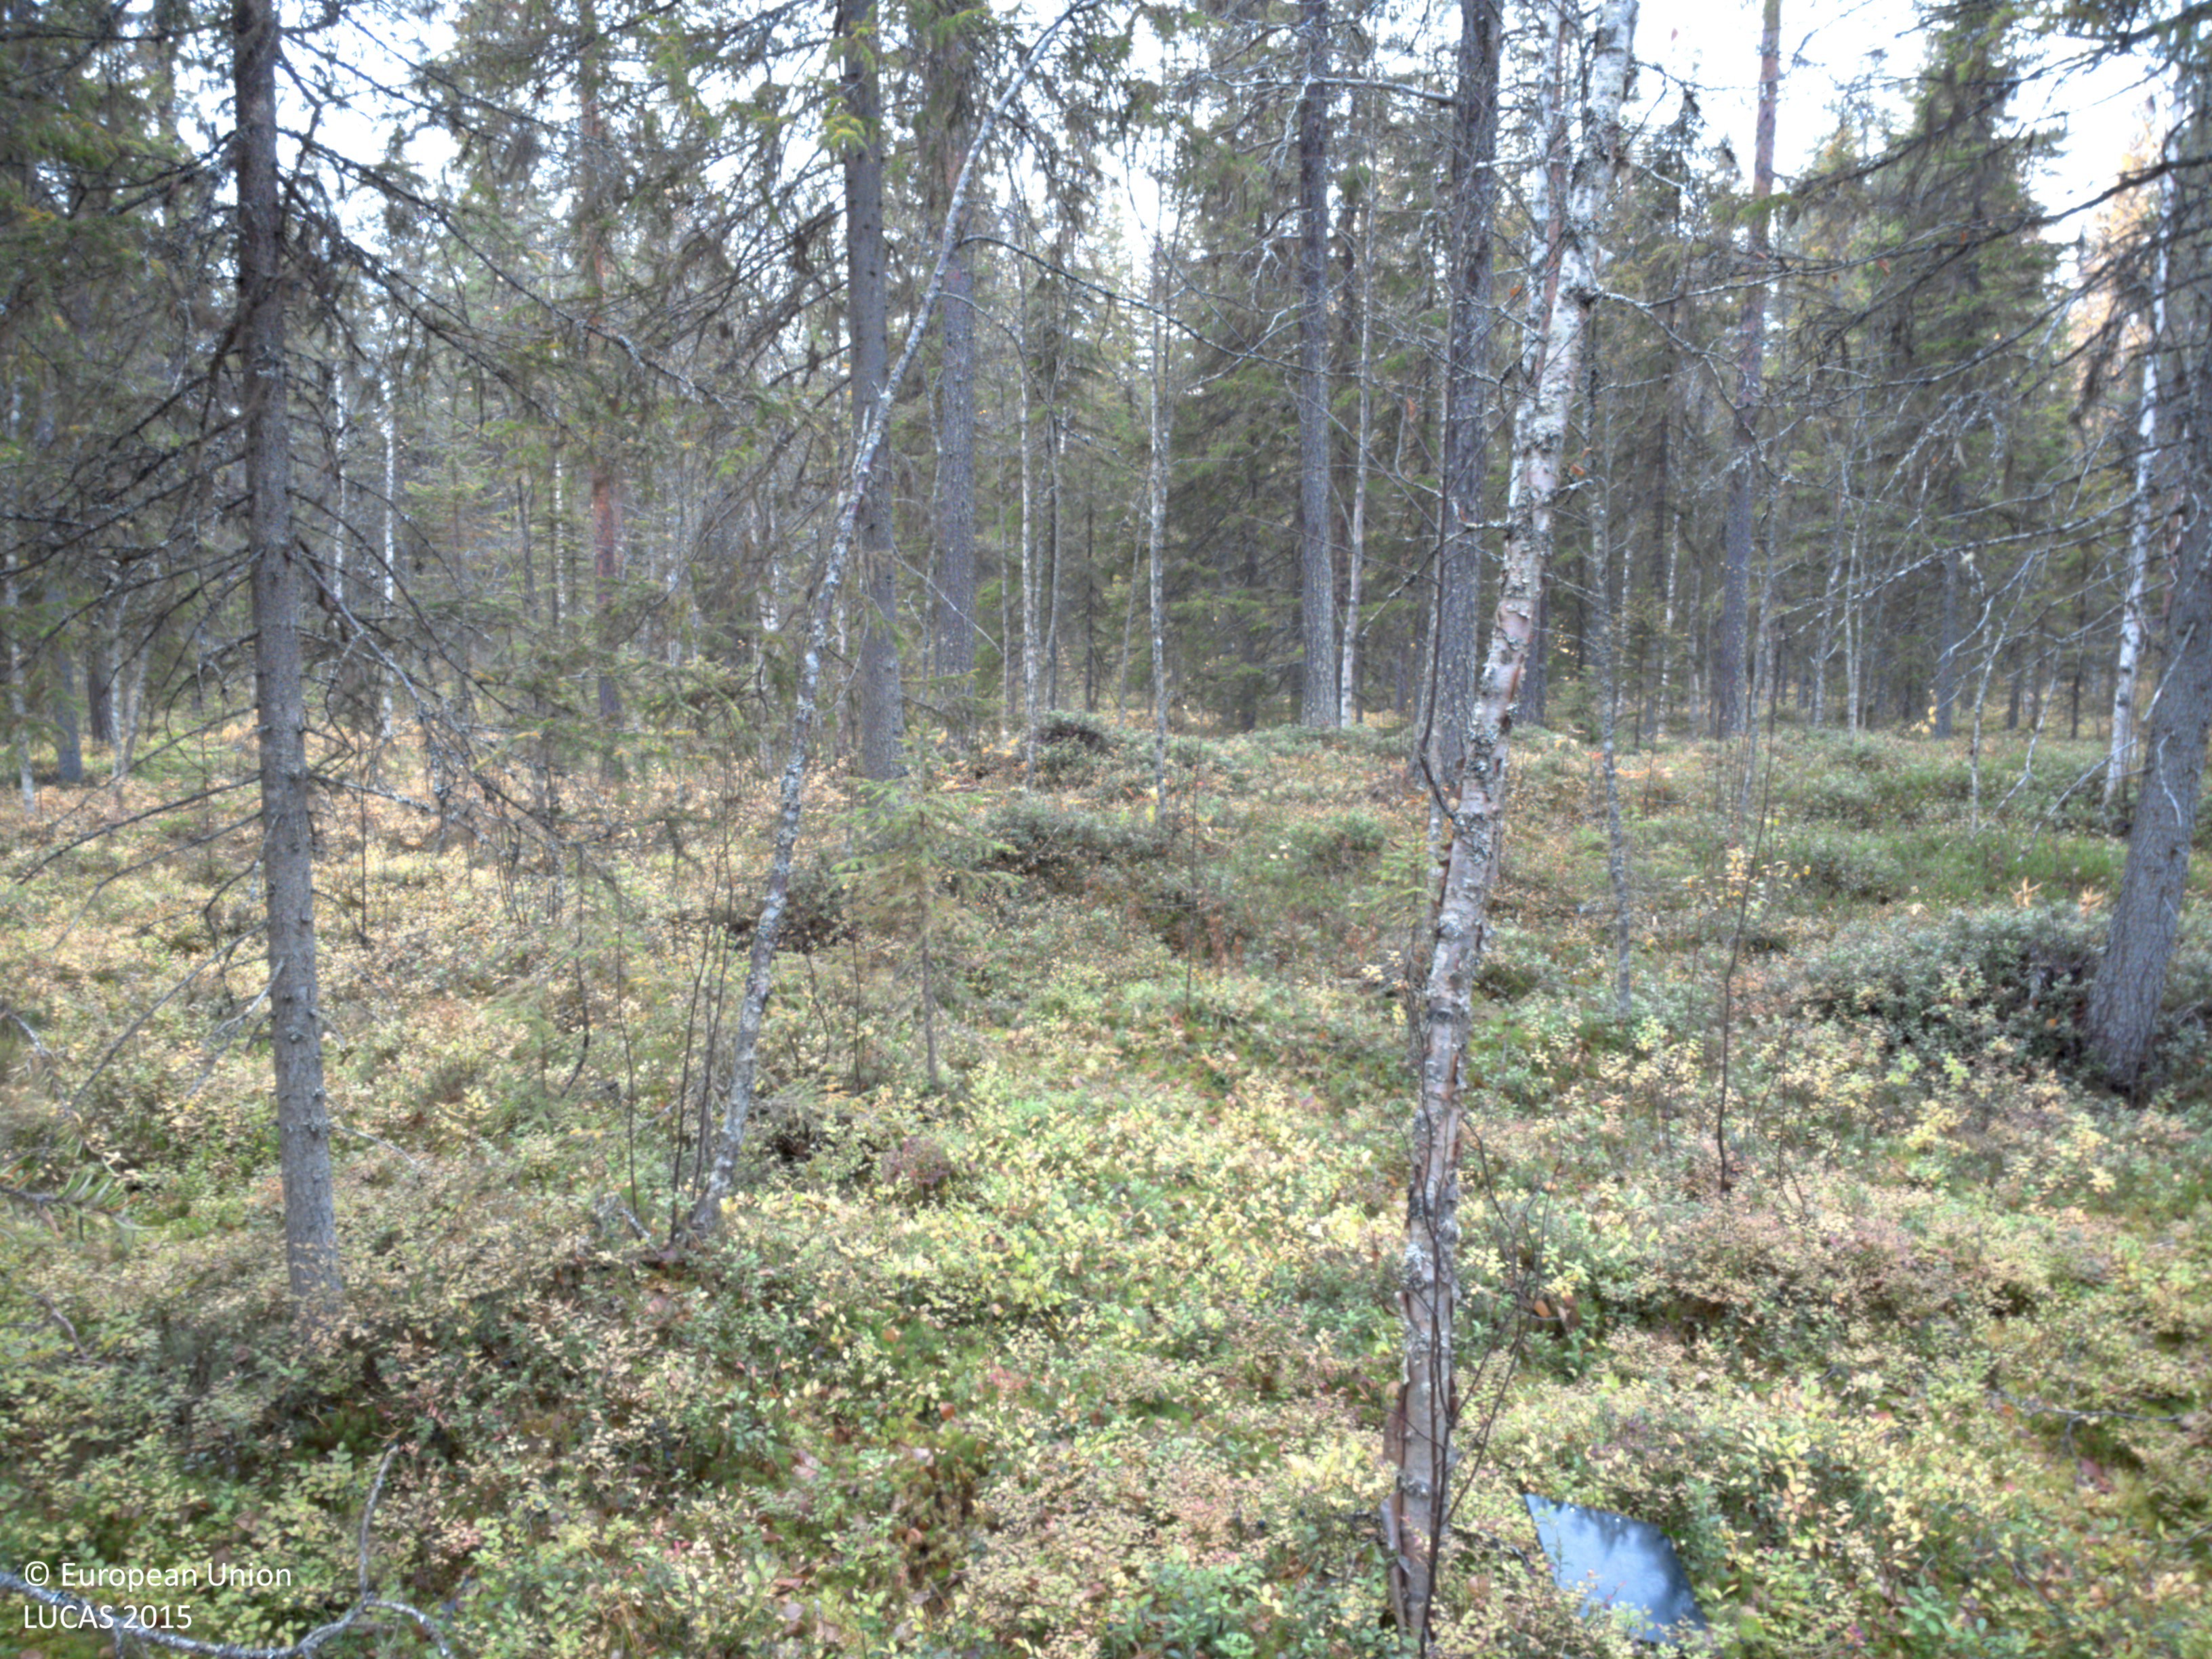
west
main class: Woodland
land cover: Spruce dominated coniferous woodland
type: boreal forest
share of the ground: > 75 %
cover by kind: coniferous forest trees 70 %, shrubs 20 %, broadleaved forest trees 5 %, lichens and mosses 5 %
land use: Forestry
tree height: > 5 m
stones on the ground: < 10 %
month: October
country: SE
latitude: 64.9494
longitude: 18.1981
